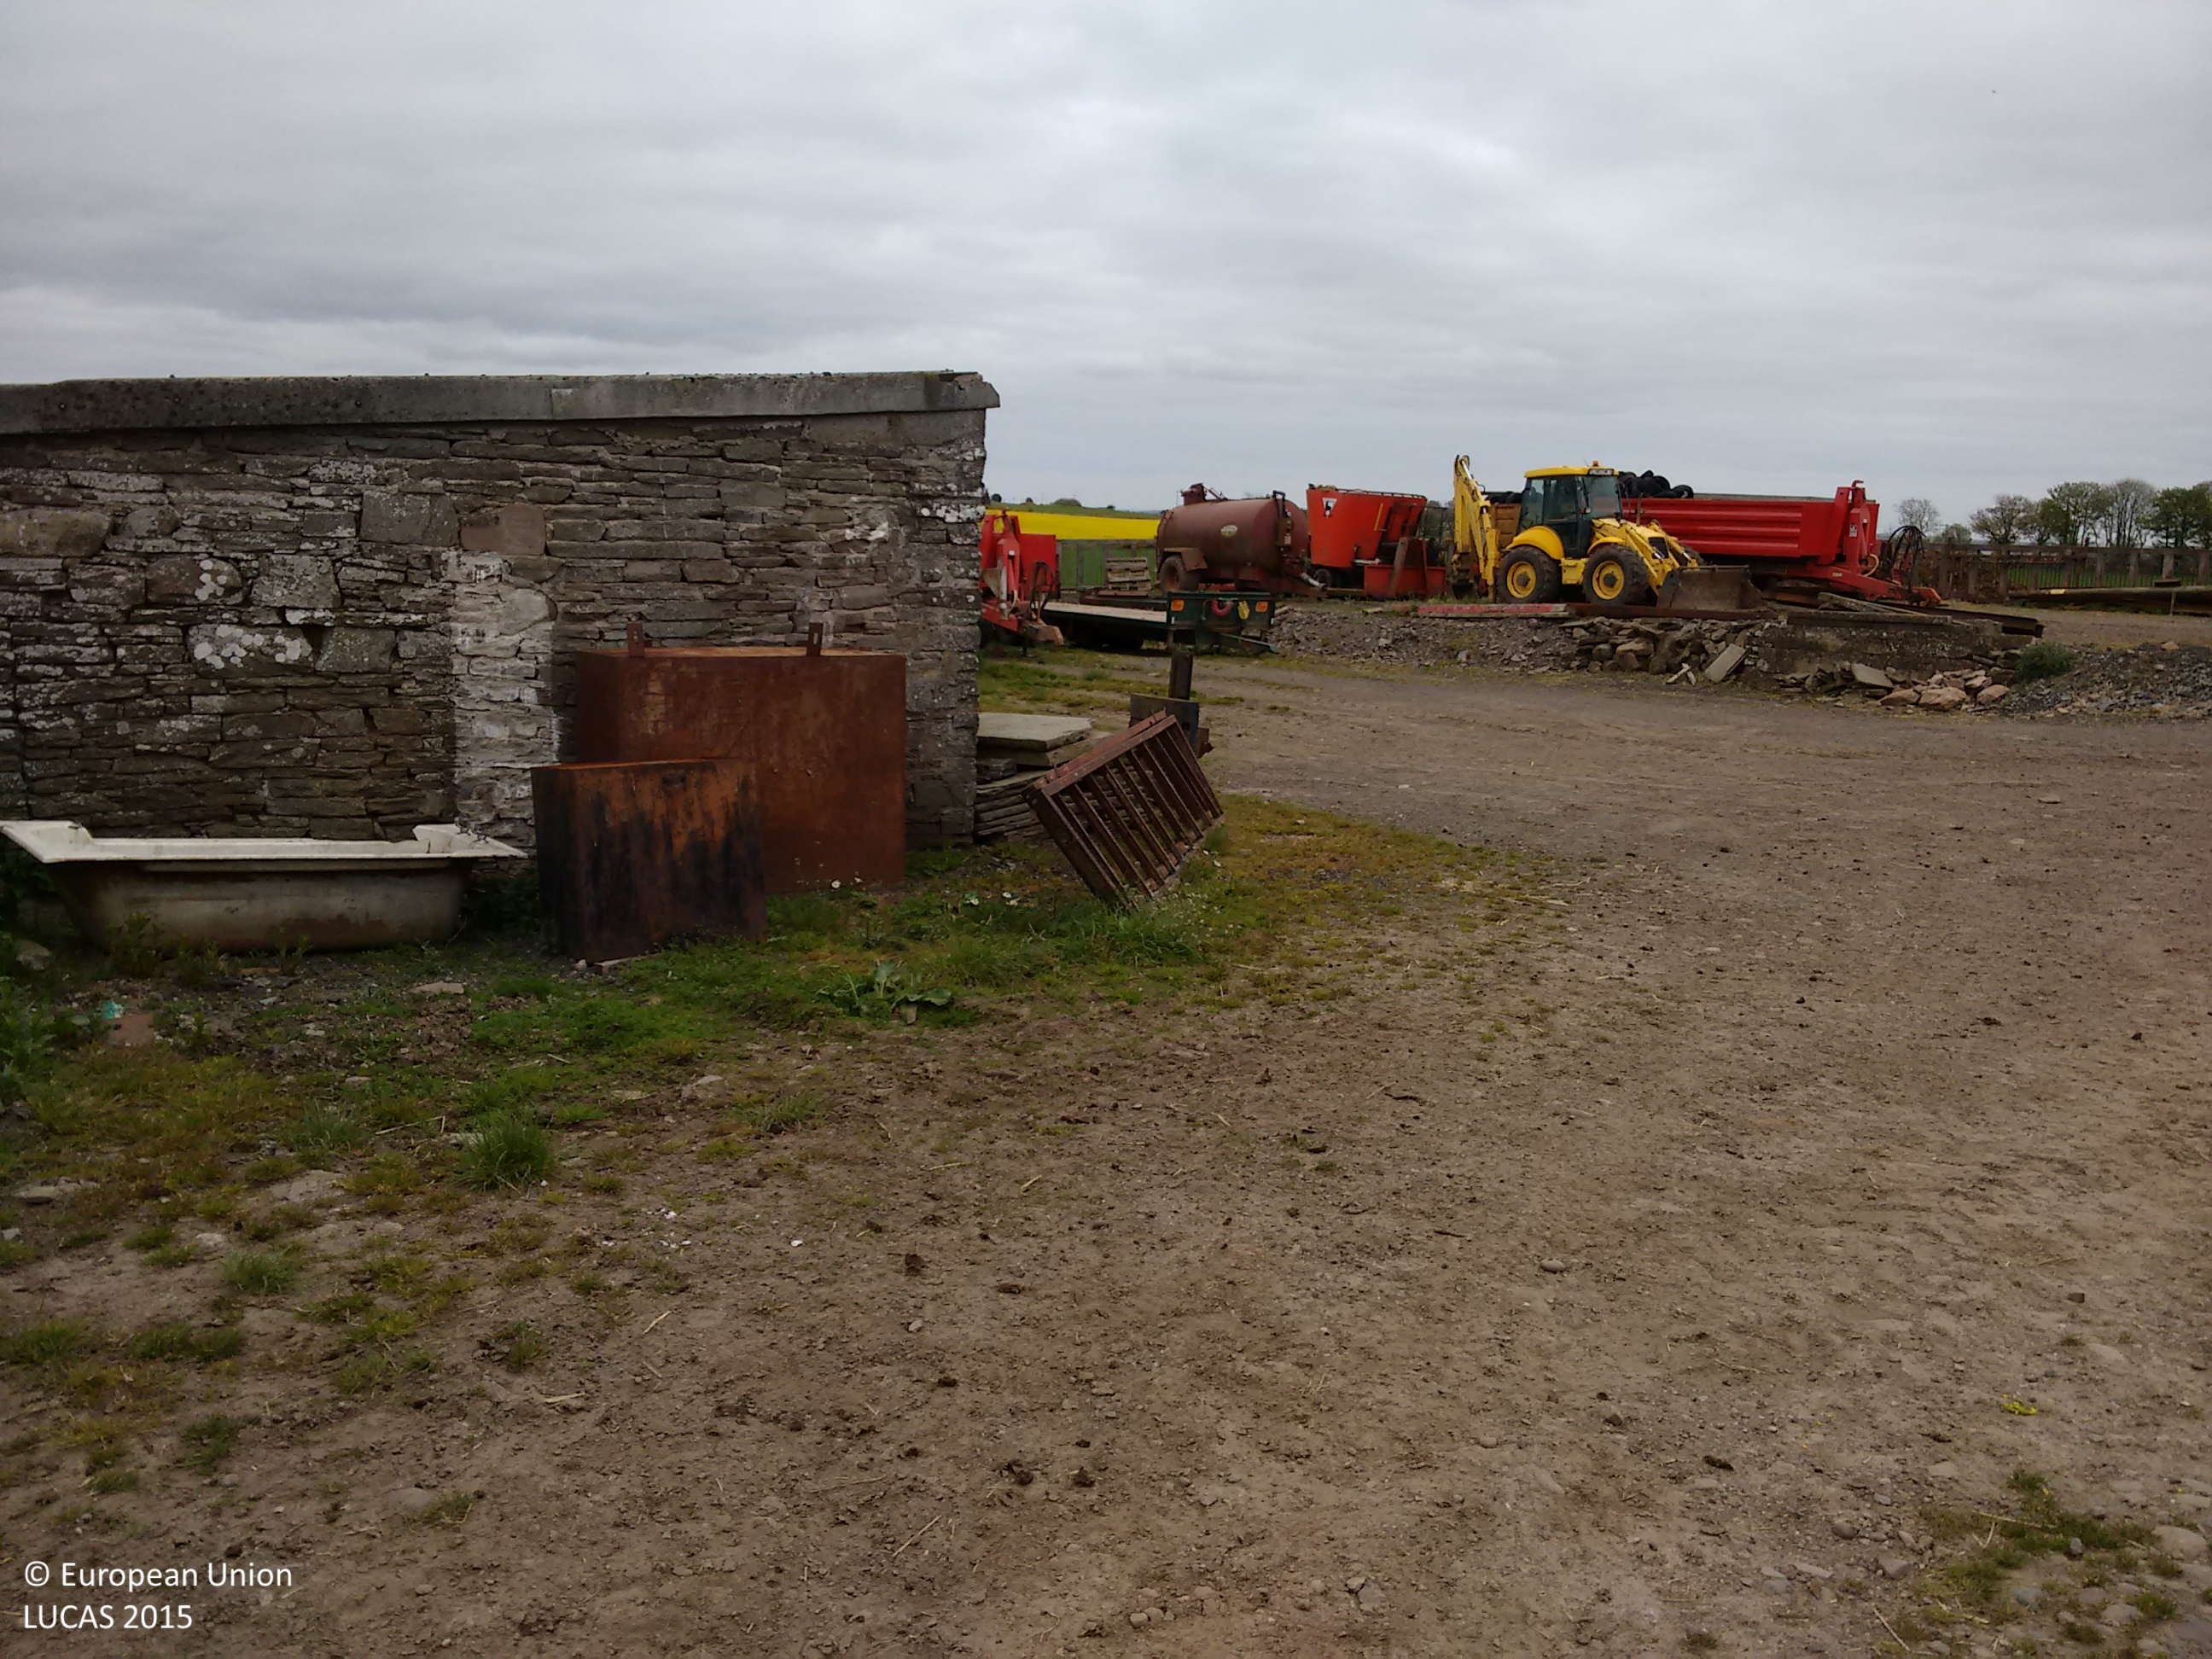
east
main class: Grassland
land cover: Grassland without tree/shrub cover
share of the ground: 50 - 75 %
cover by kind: herbaceous plants 75 %, unconsolidated bare surface 25 %
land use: Agriculture (excluding fallow land and kitchen gardens)
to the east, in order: Grassland without tree/shrub cover; Dry stone walls; Artificial constructions in urban areas; Grass margins; Barley
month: May
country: GB
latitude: 56.6763
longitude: -2.7753
